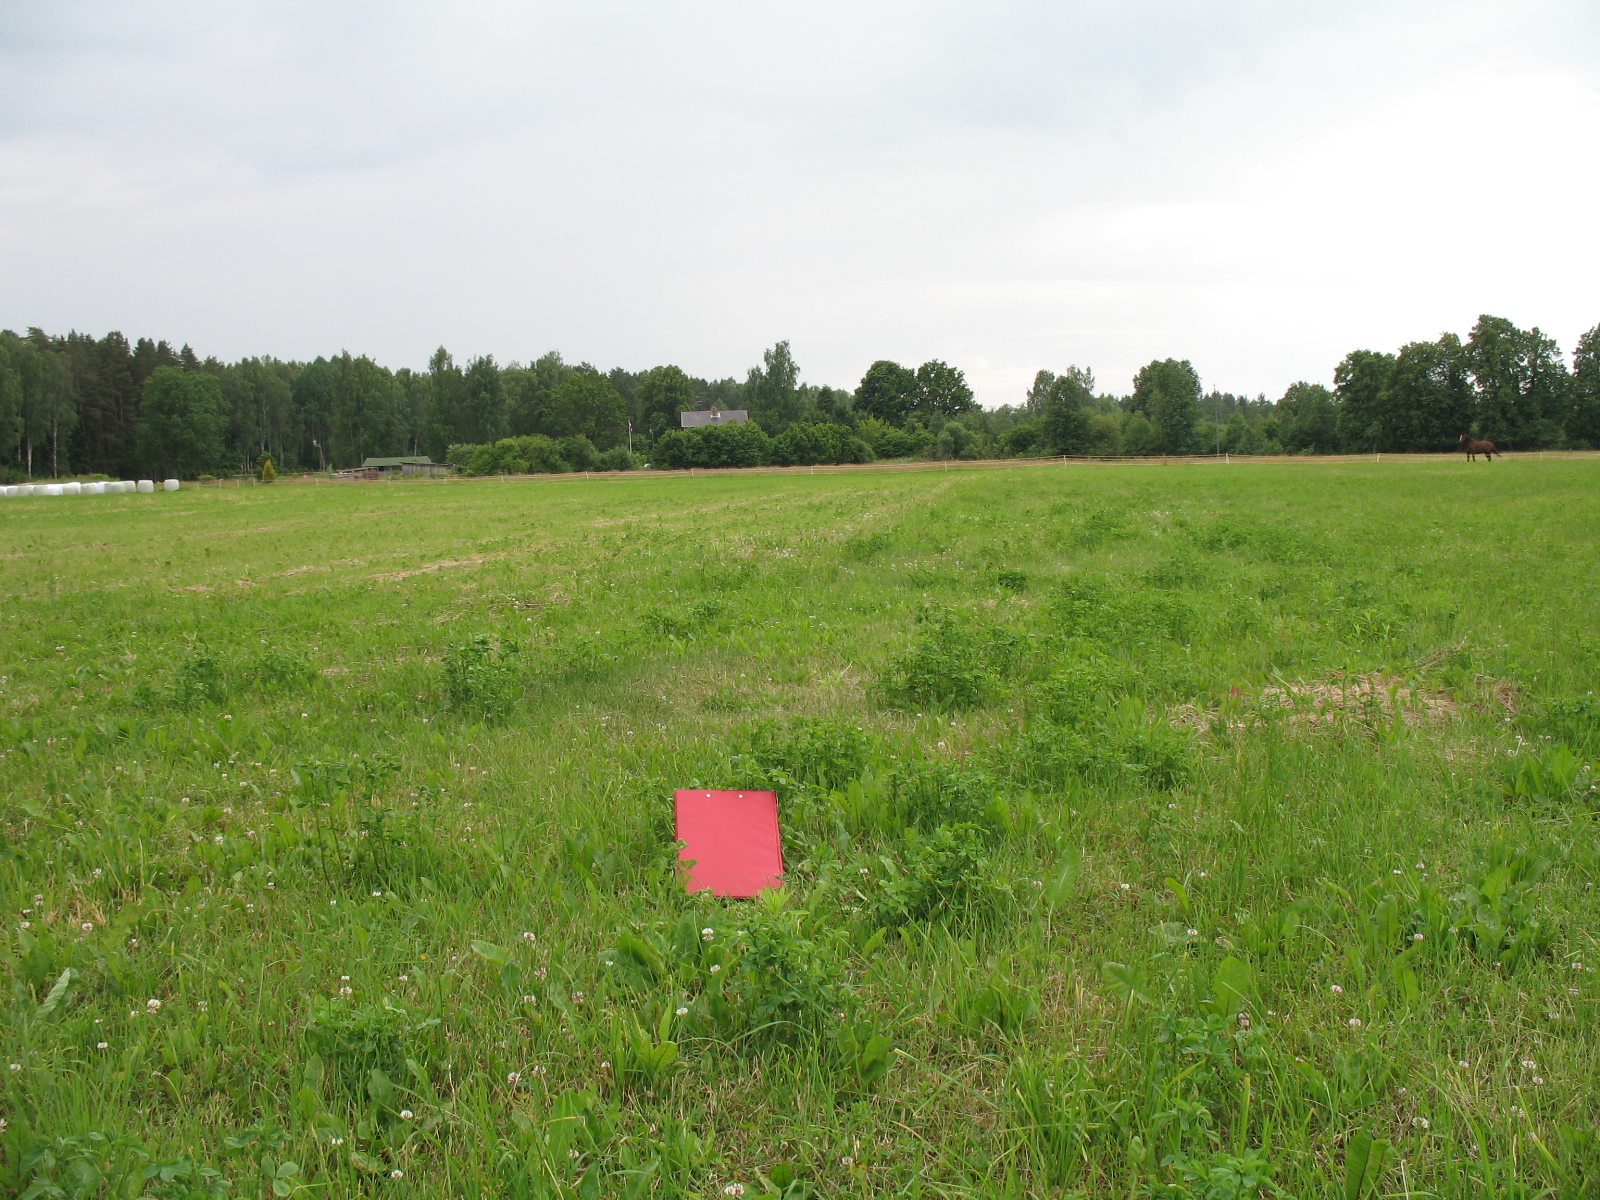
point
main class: Grassland
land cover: Grassland without tree/shrub cover
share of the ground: > 75 %
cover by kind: herbaceous plants 100 %
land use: Agriculture (excluding fallow land and kitchen gardens)
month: June
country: LV
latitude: 56.7144
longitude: 23.8205
